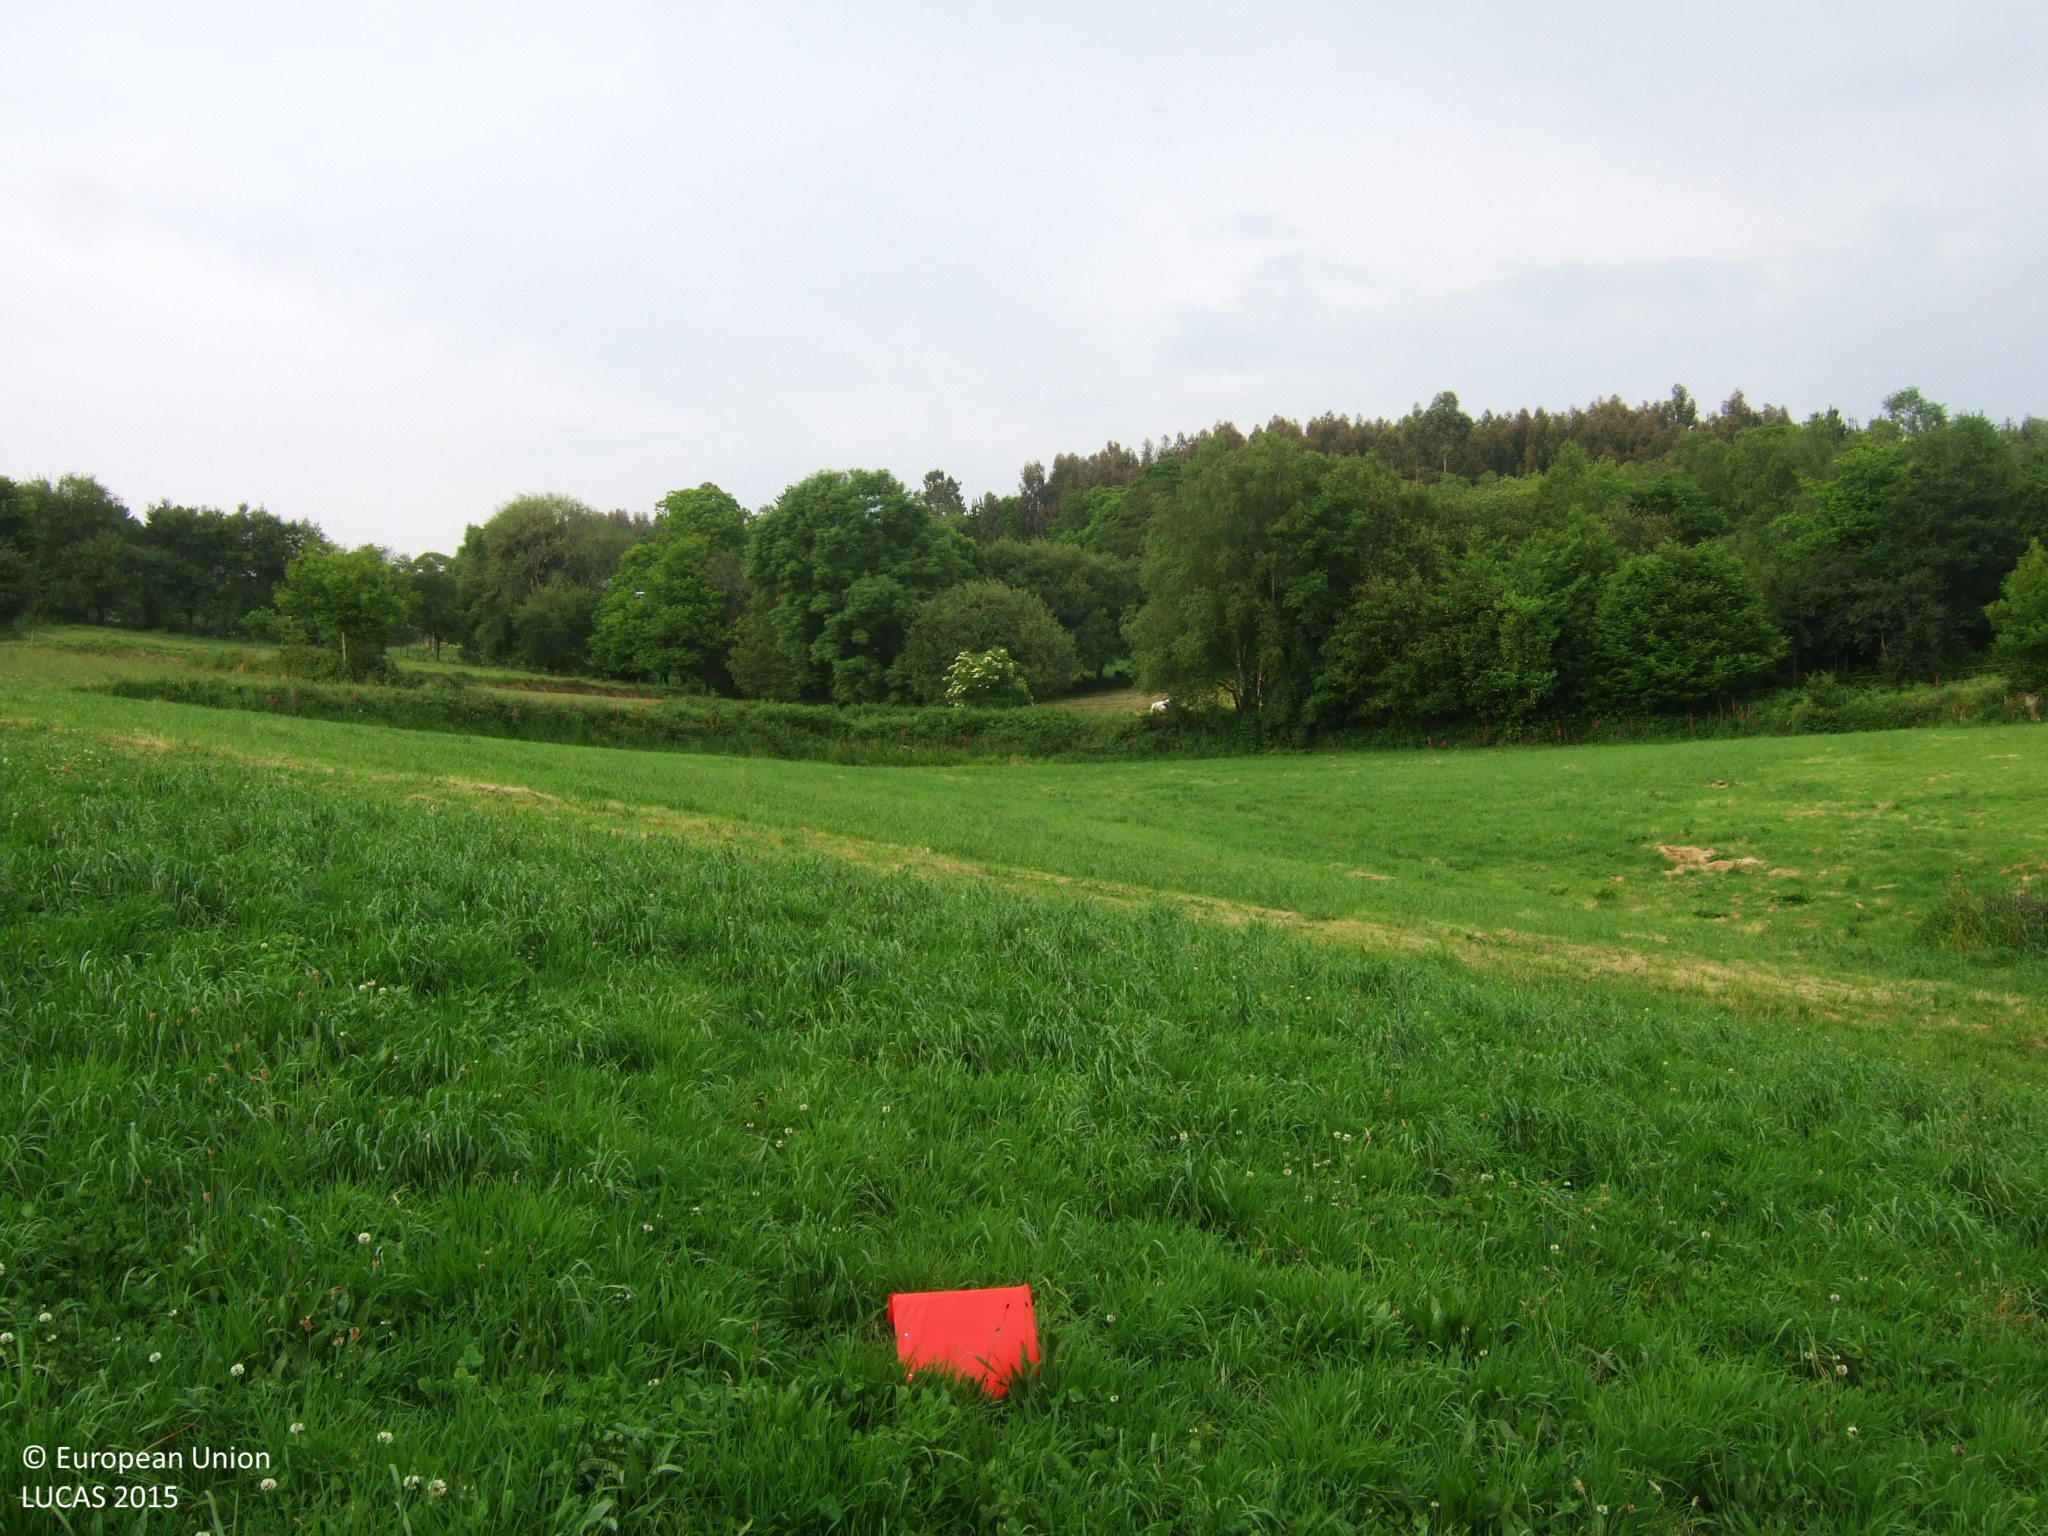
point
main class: Grassland
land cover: Grassland without tree/shrub cover
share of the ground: > 75 %
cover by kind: herbaceous plants 100 %
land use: Agriculture (excluding fallow land and kitchen gardens)
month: June
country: ES
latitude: 43.3007
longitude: -7.4465
